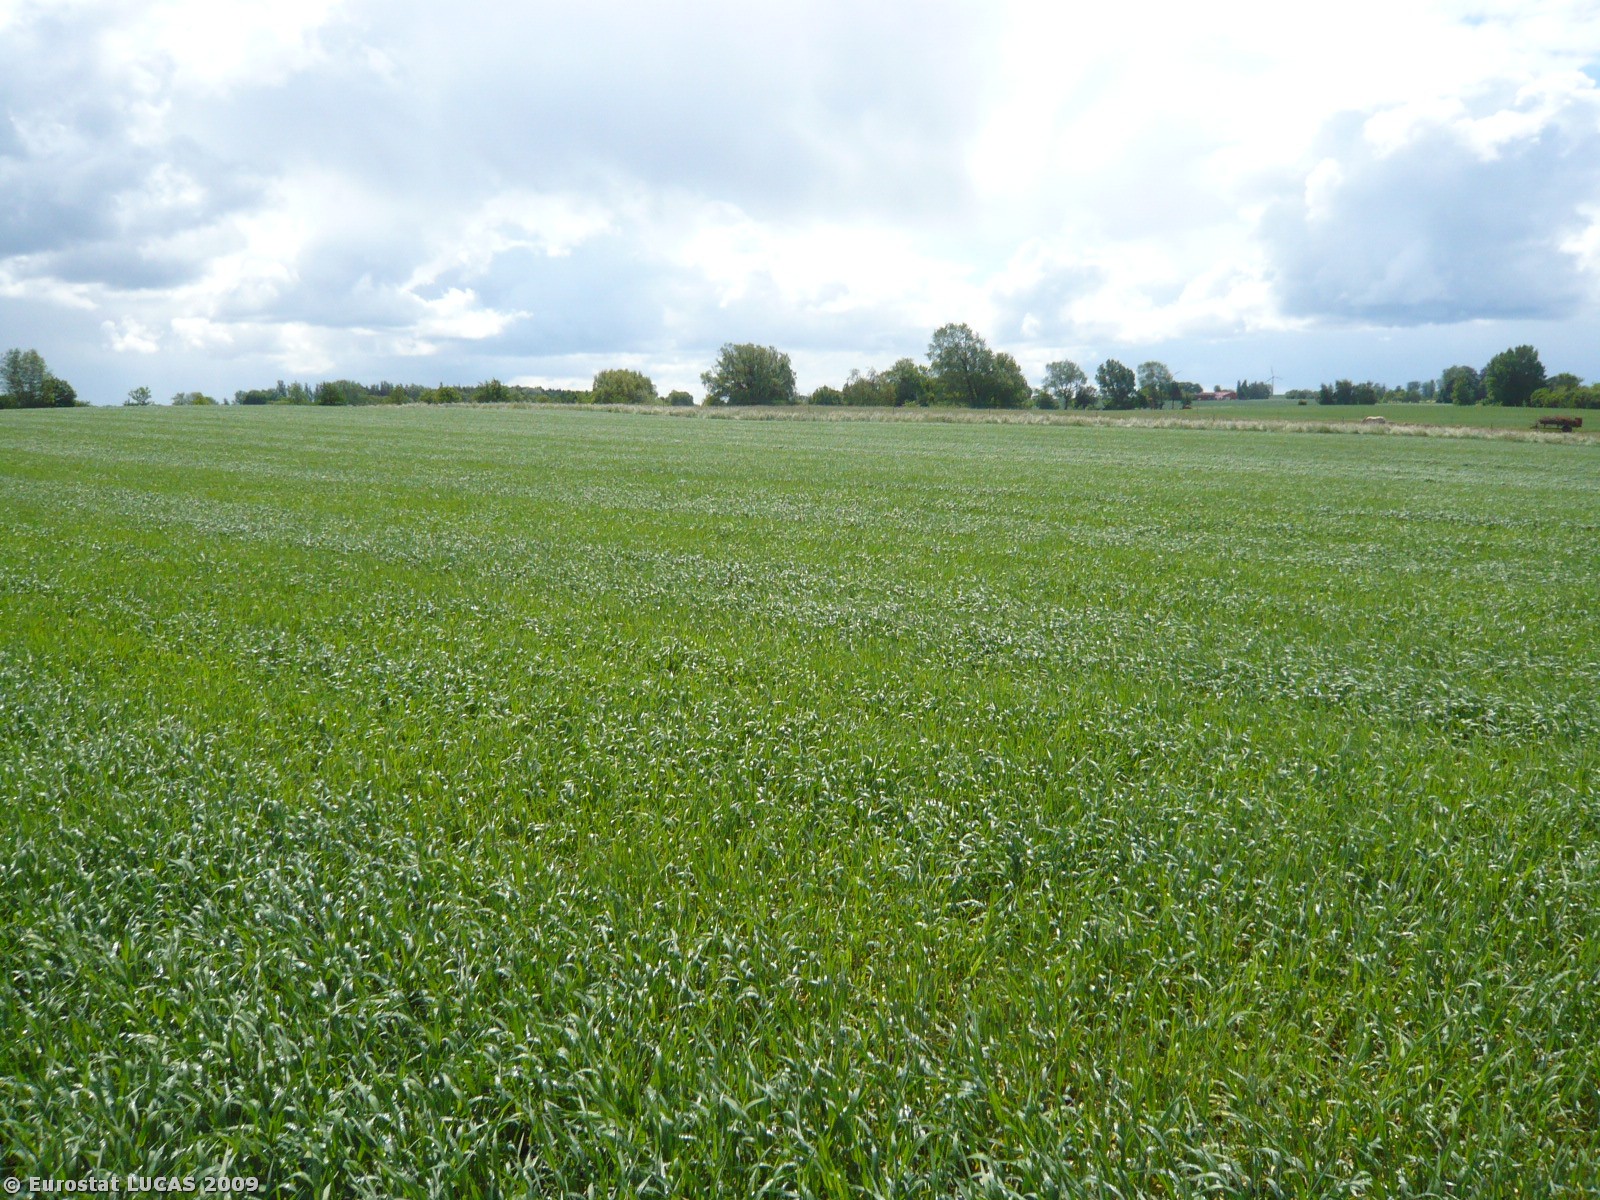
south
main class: Cropland
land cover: Barley
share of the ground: > 75 %
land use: Agriculture (excluding fallow land and kitchen gardens)
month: June
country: DK
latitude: 55.2071
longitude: 11.5859
